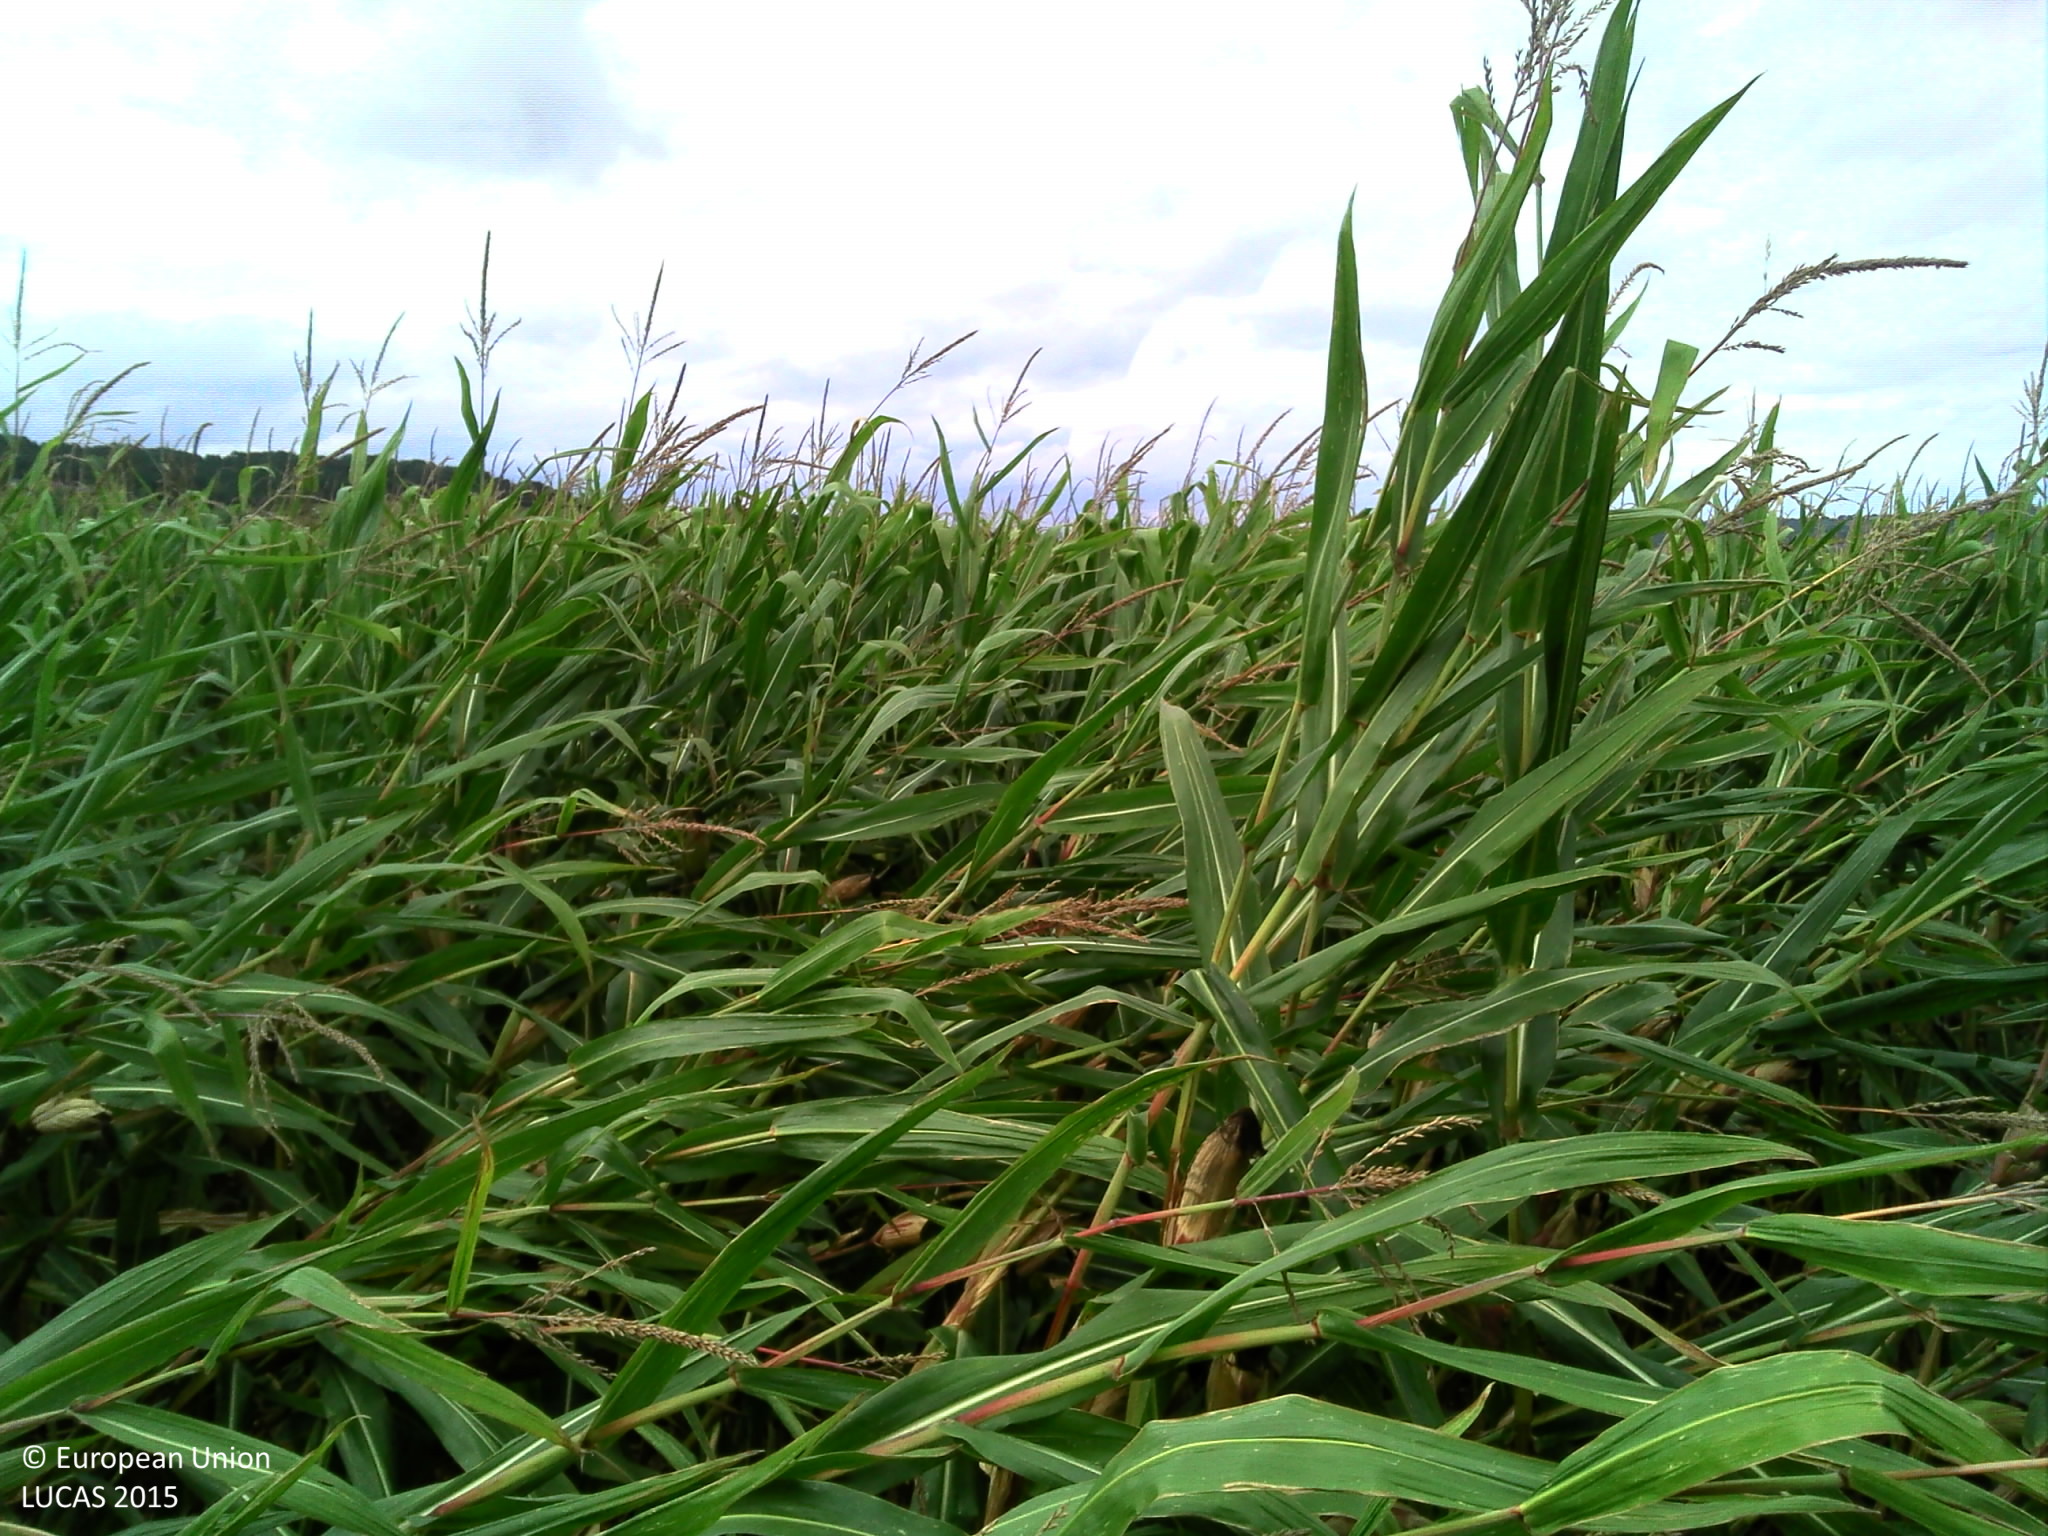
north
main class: Cropland
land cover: Maize
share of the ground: > 75 %
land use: Agriculture (excluding fallow land and kitchen gardens)
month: September
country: FR
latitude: 43.4850
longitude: -0.1825
